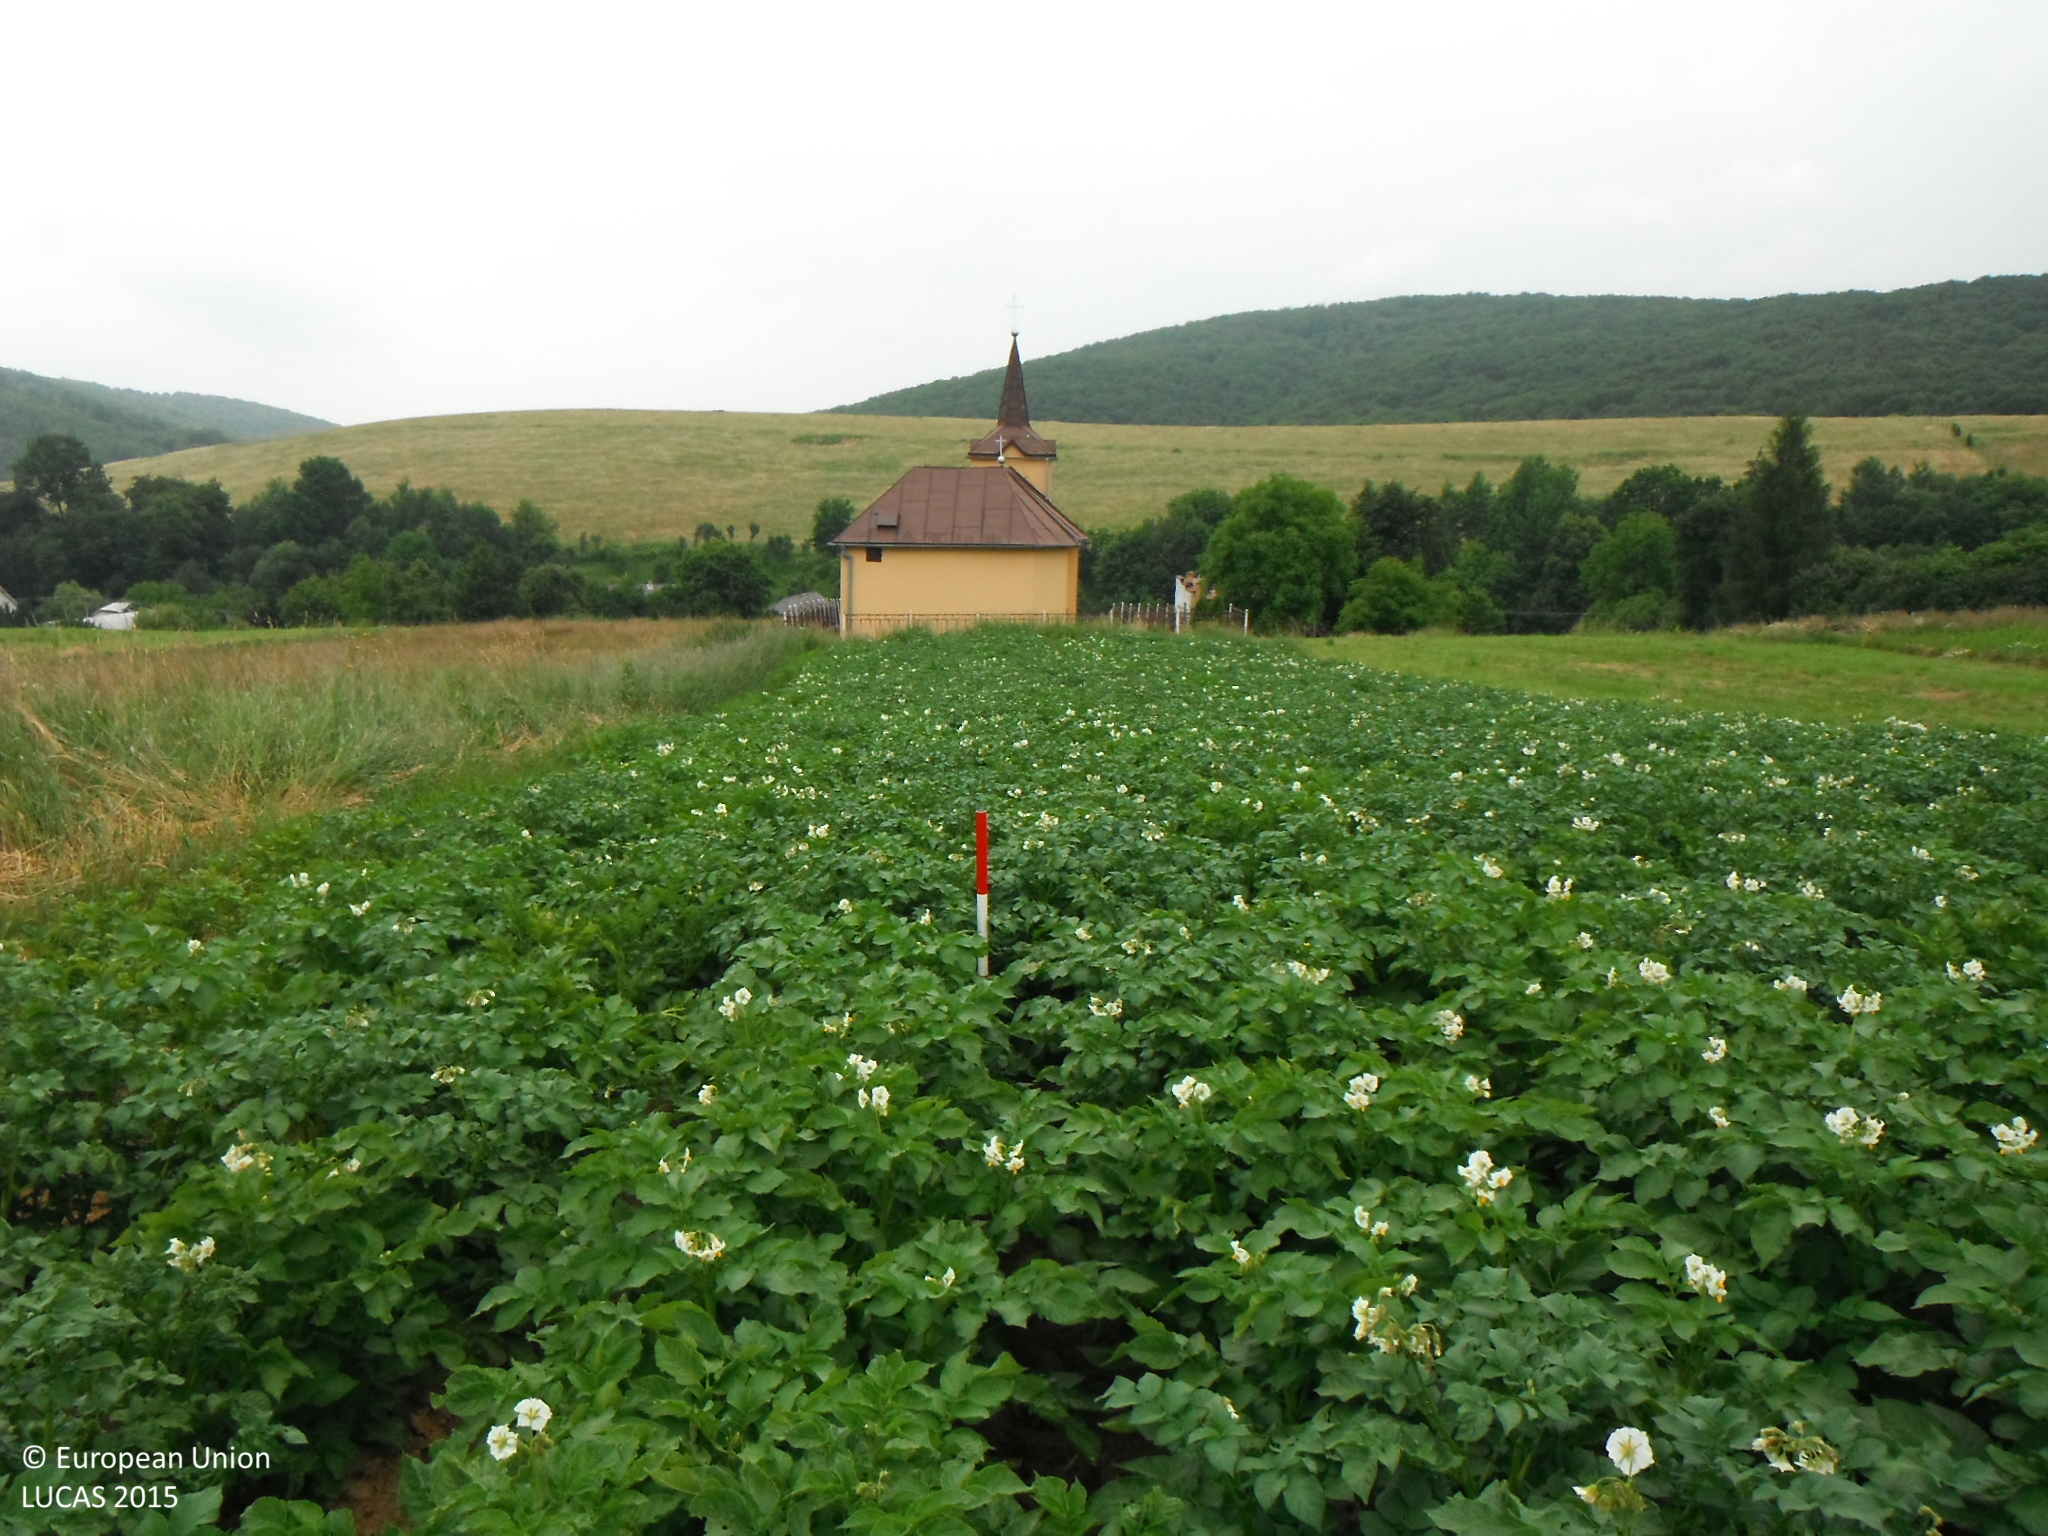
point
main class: Cropland
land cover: Potatoes
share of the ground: > 75 %
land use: Agriculture (excluding fallow land and kitchen gardens)
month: June
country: SK
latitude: 49.1883
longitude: 21.6171
